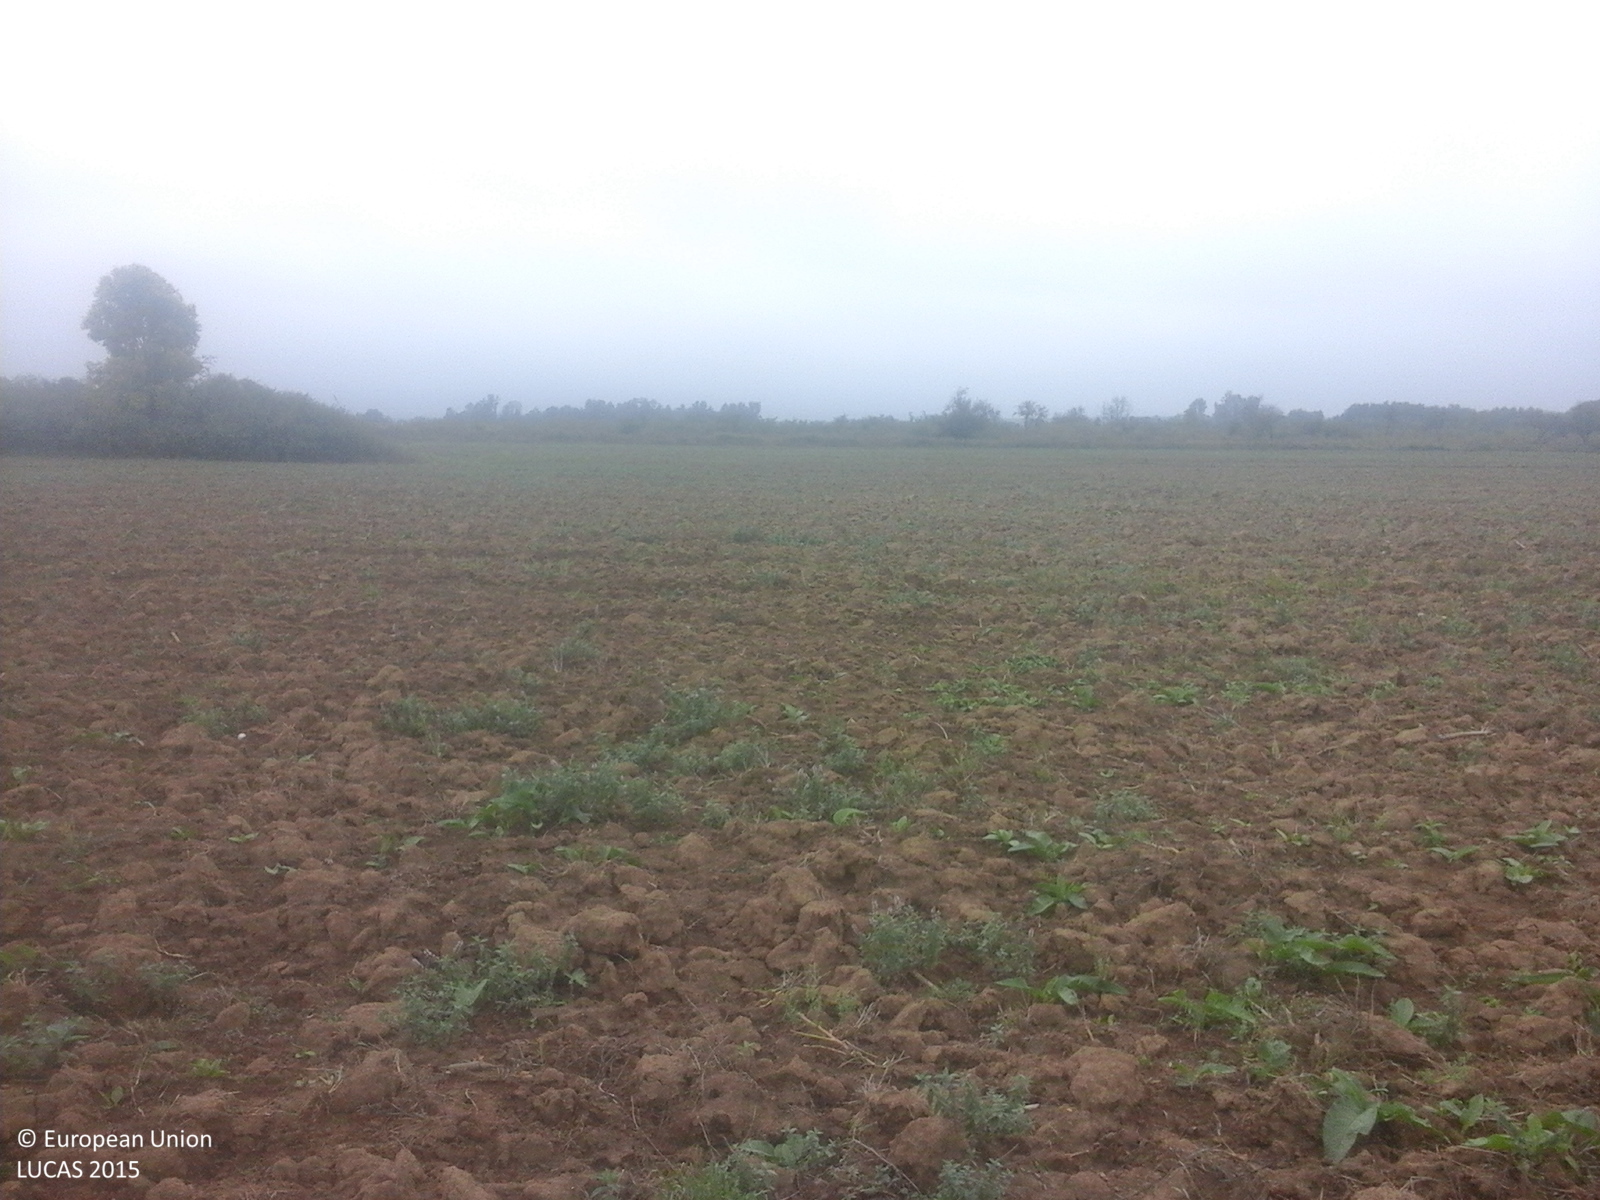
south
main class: Cropland
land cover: Maize
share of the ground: < 10 %
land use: Agriculture (excluding fallow land and kitchen gardens)
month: September
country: RO
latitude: 45.8456
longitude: 22.0814
